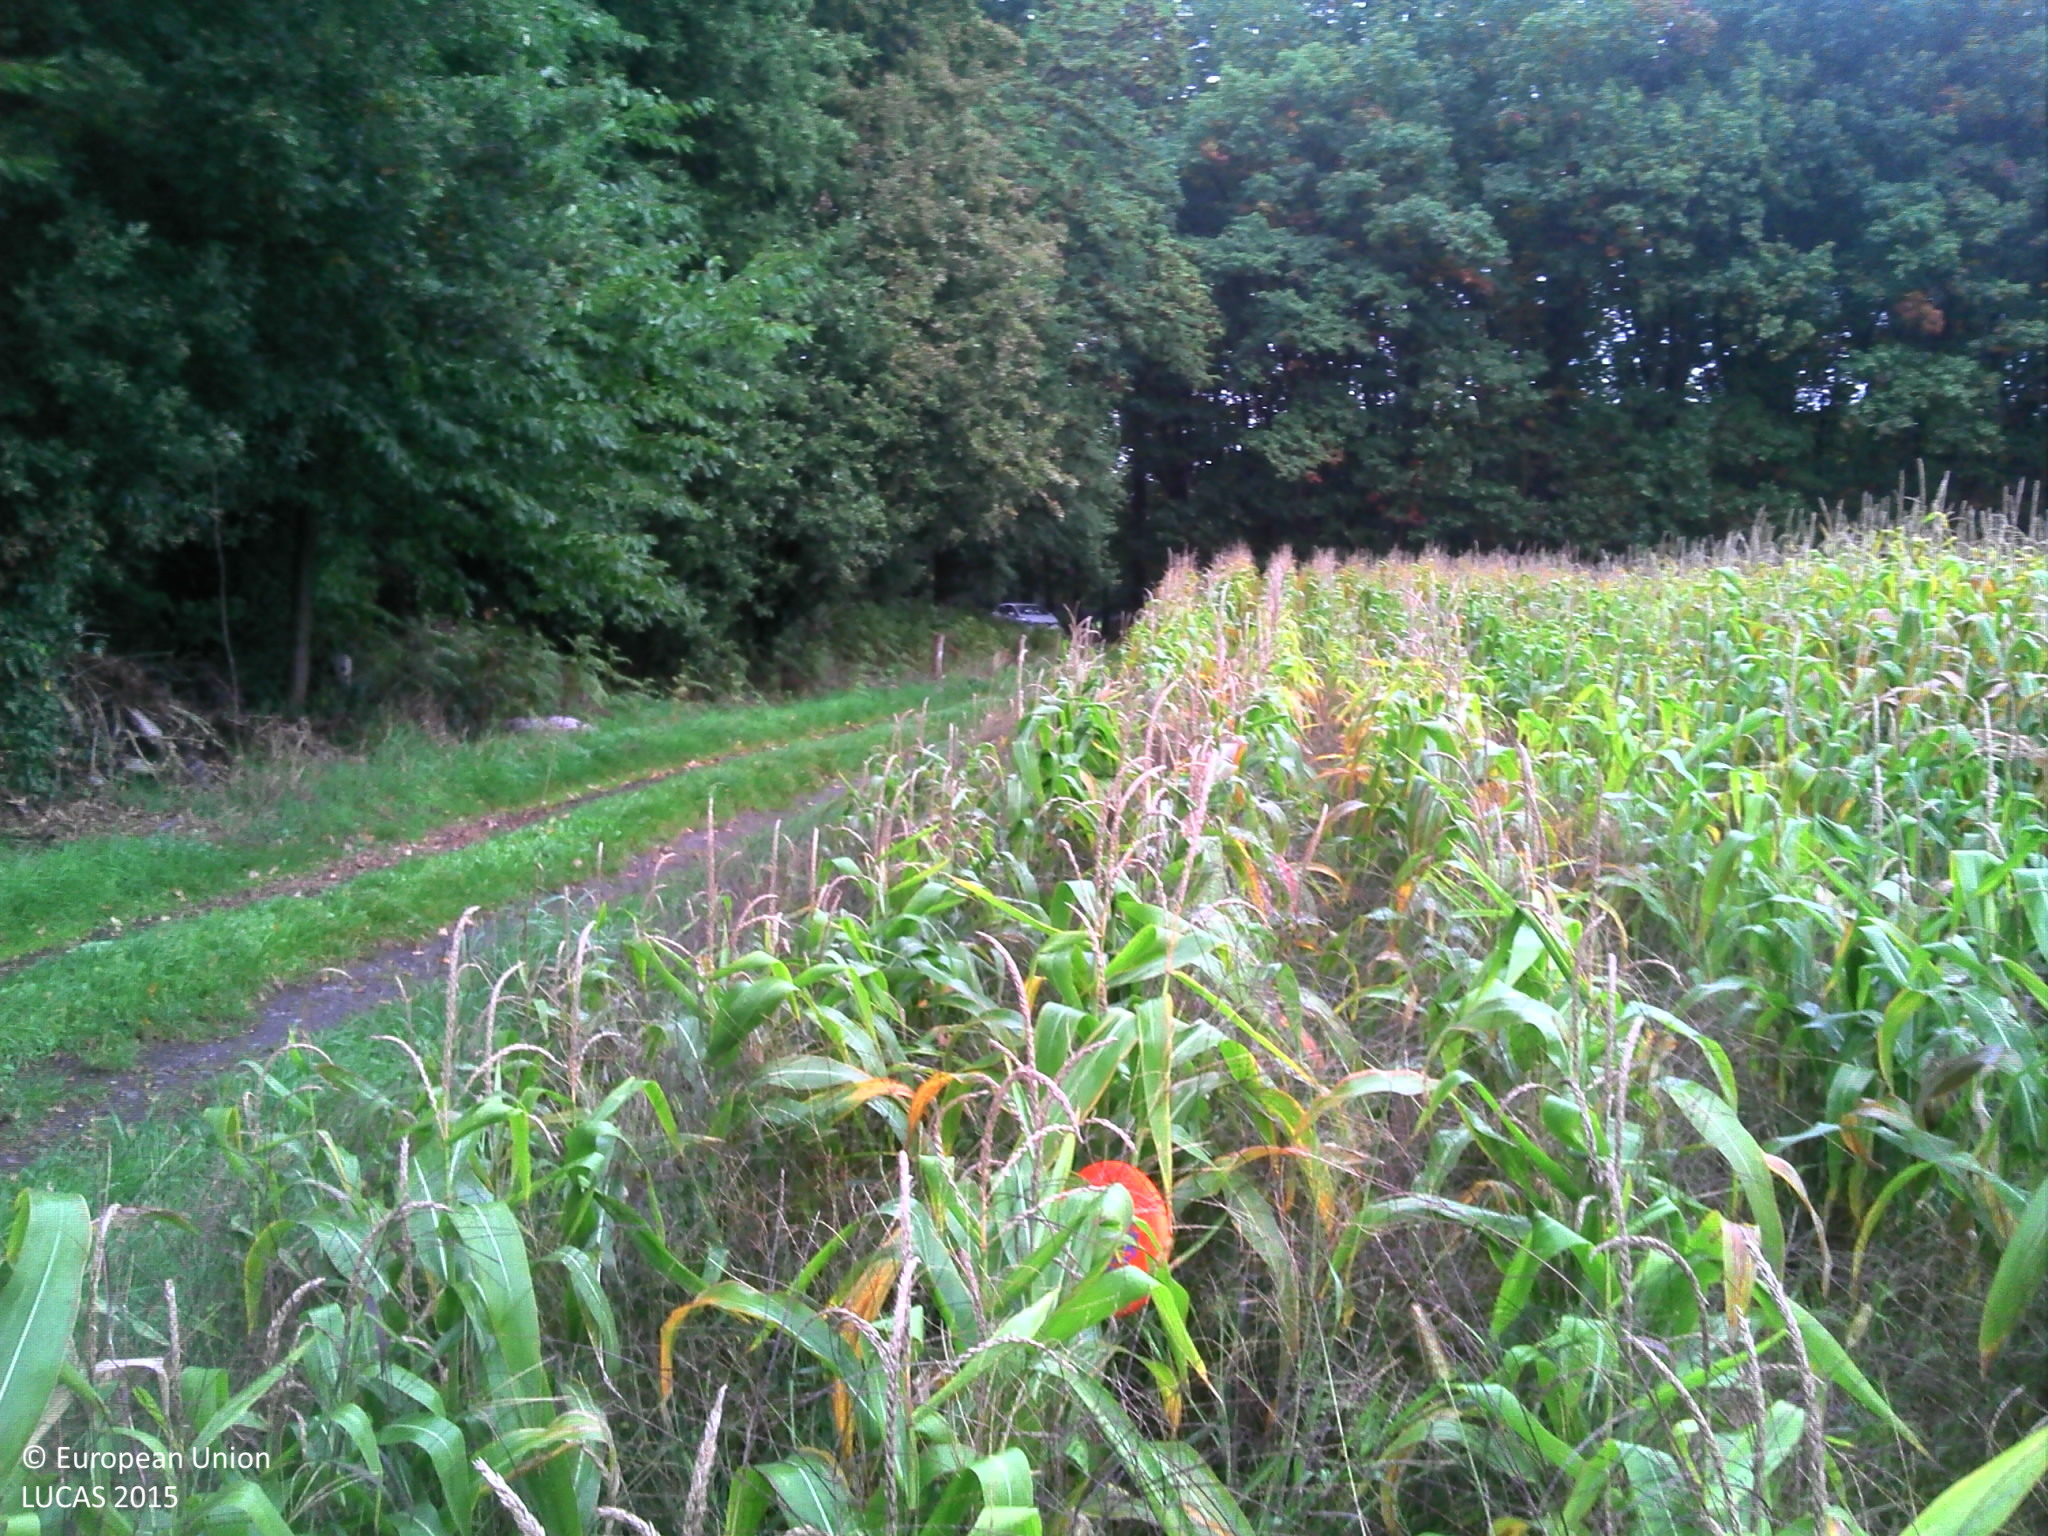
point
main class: Cropland
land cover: Maize
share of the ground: > 75 %
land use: Agriculture (excluding fallow land and kitchen gardens)
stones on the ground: < 10 %
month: October
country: BE
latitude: 51.1086
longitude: 4.7545
